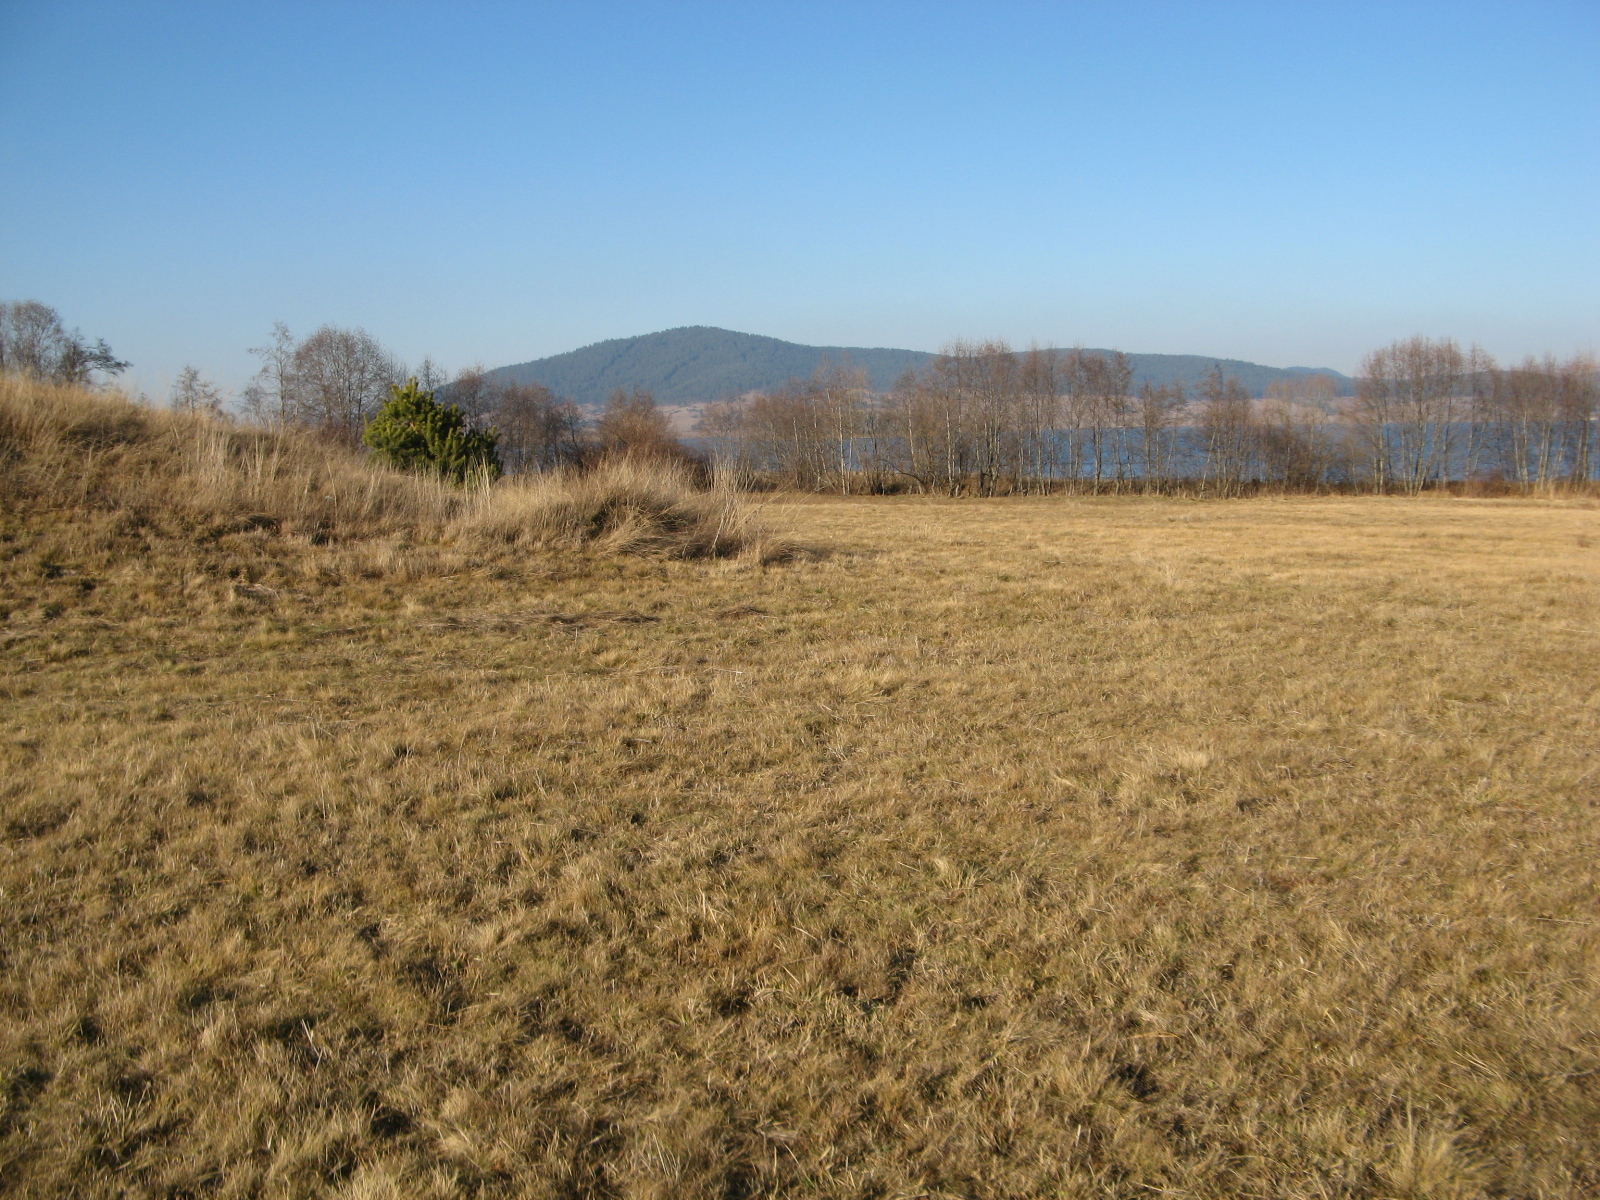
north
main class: Grassland
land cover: Grassland without tree/shrub cover
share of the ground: > 75 %
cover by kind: herbaceous plants 100 %
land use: Agriculture (excluding fallow land and kitchen gardens)
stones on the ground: < 10 %
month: December
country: BG
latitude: 41.9458
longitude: 24.1644
